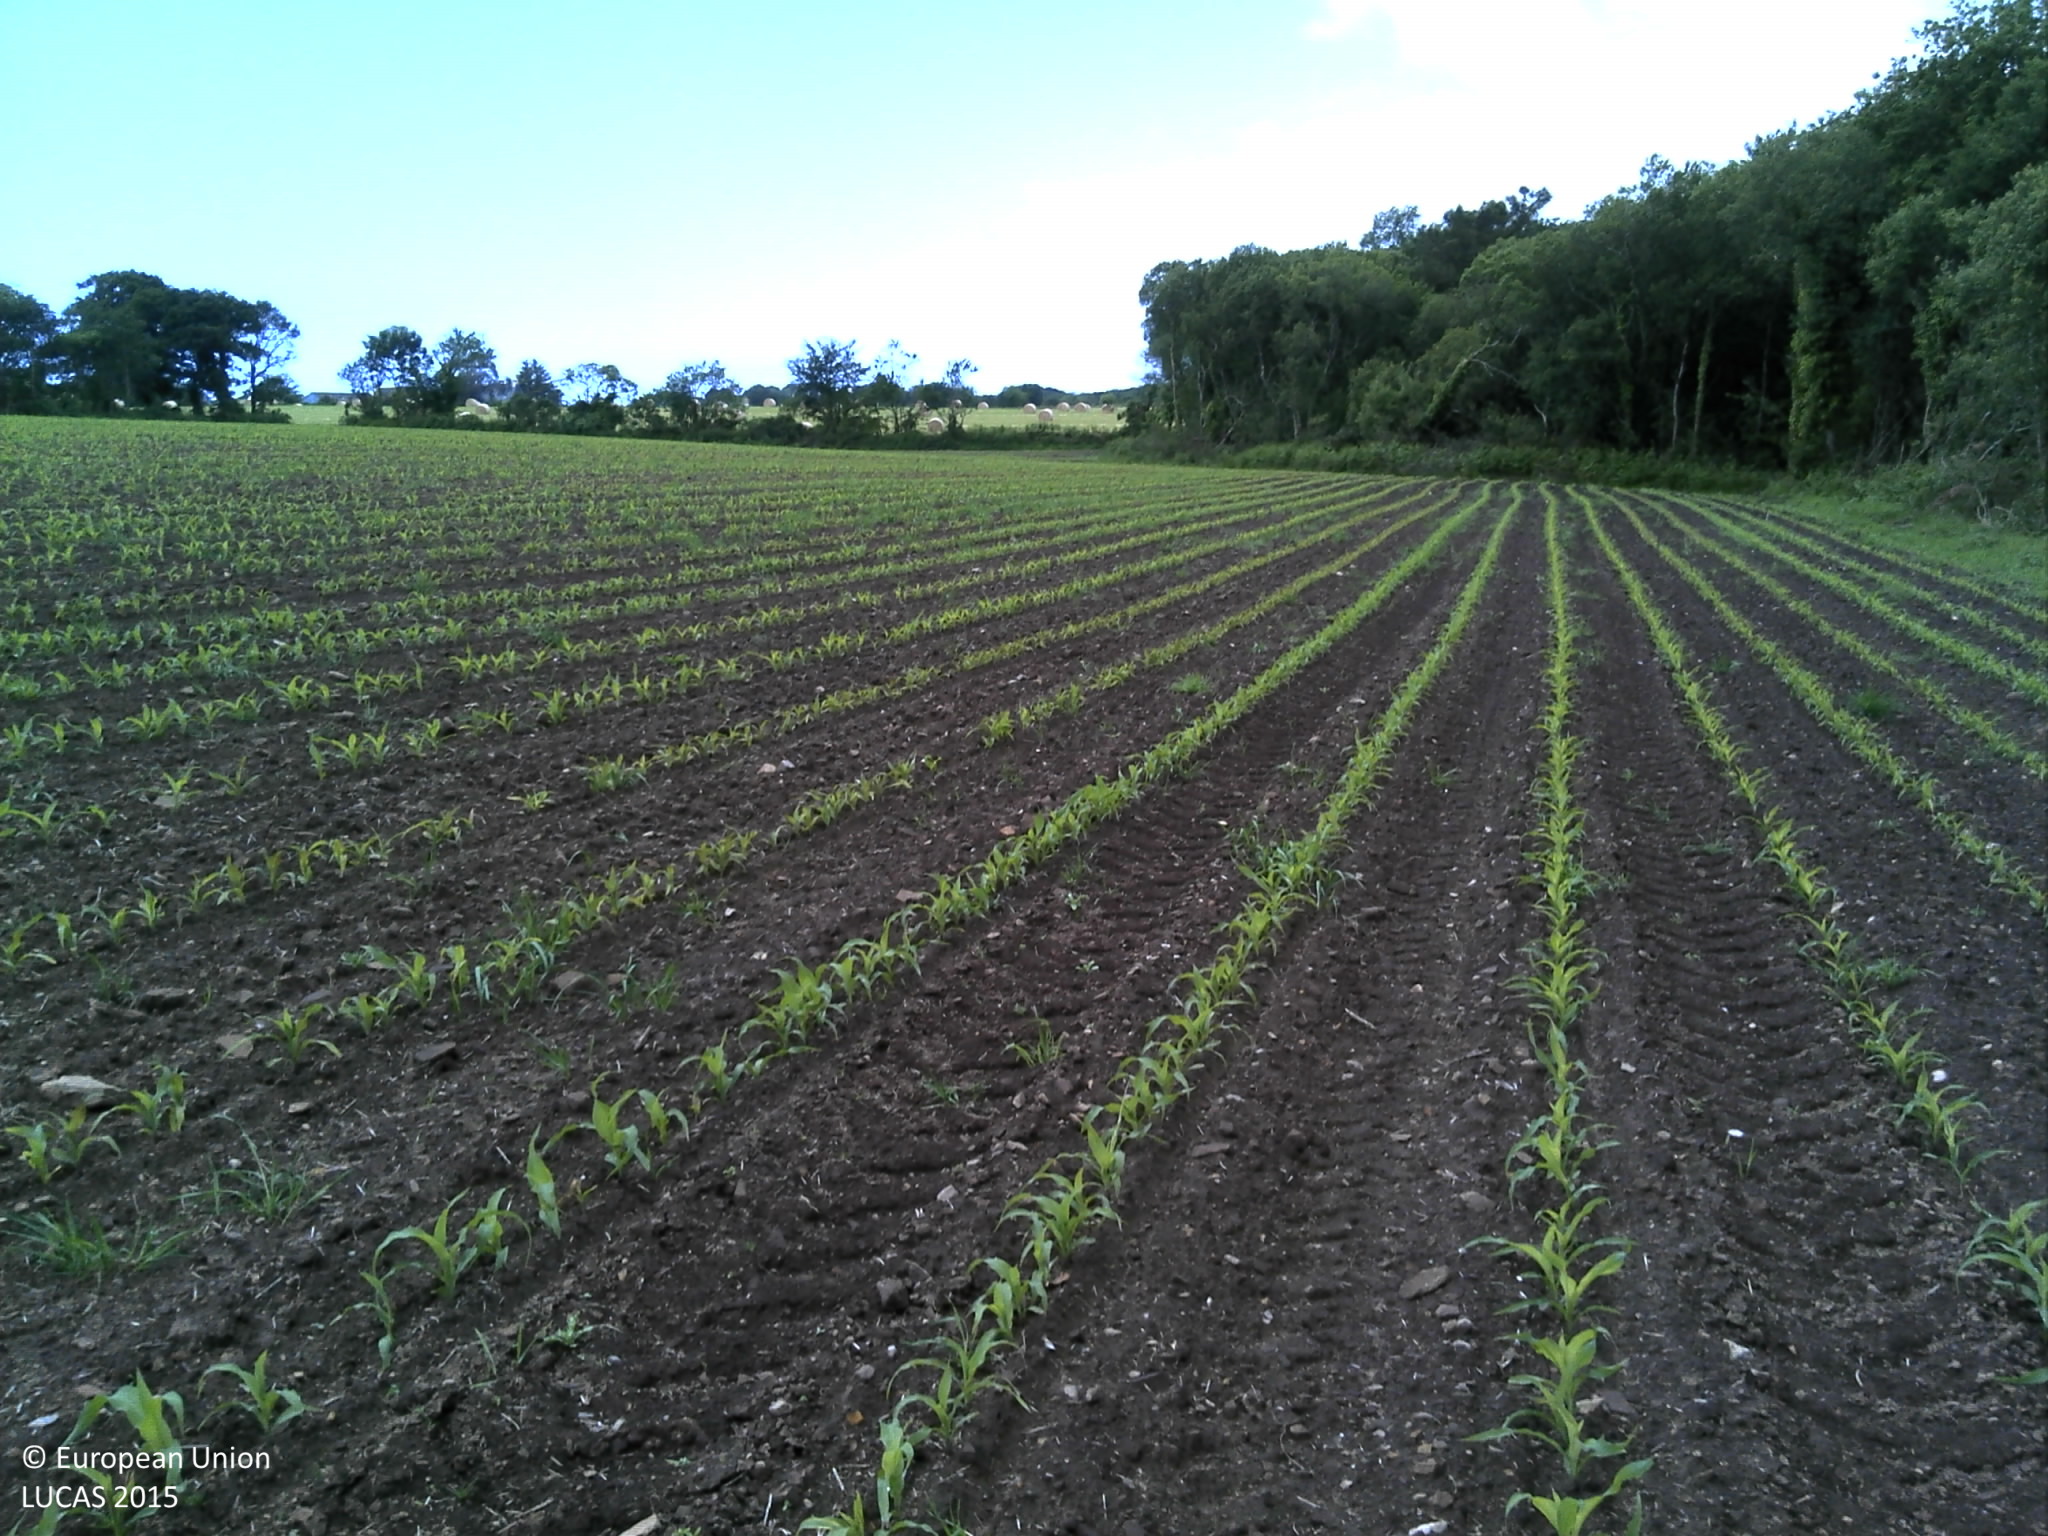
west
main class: Cropland
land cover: Maize
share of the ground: 10 - 25 %
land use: Agriculture (excluding fallow land and kitchen gardens)
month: September
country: FR
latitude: 47.8020
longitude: -3.5483
